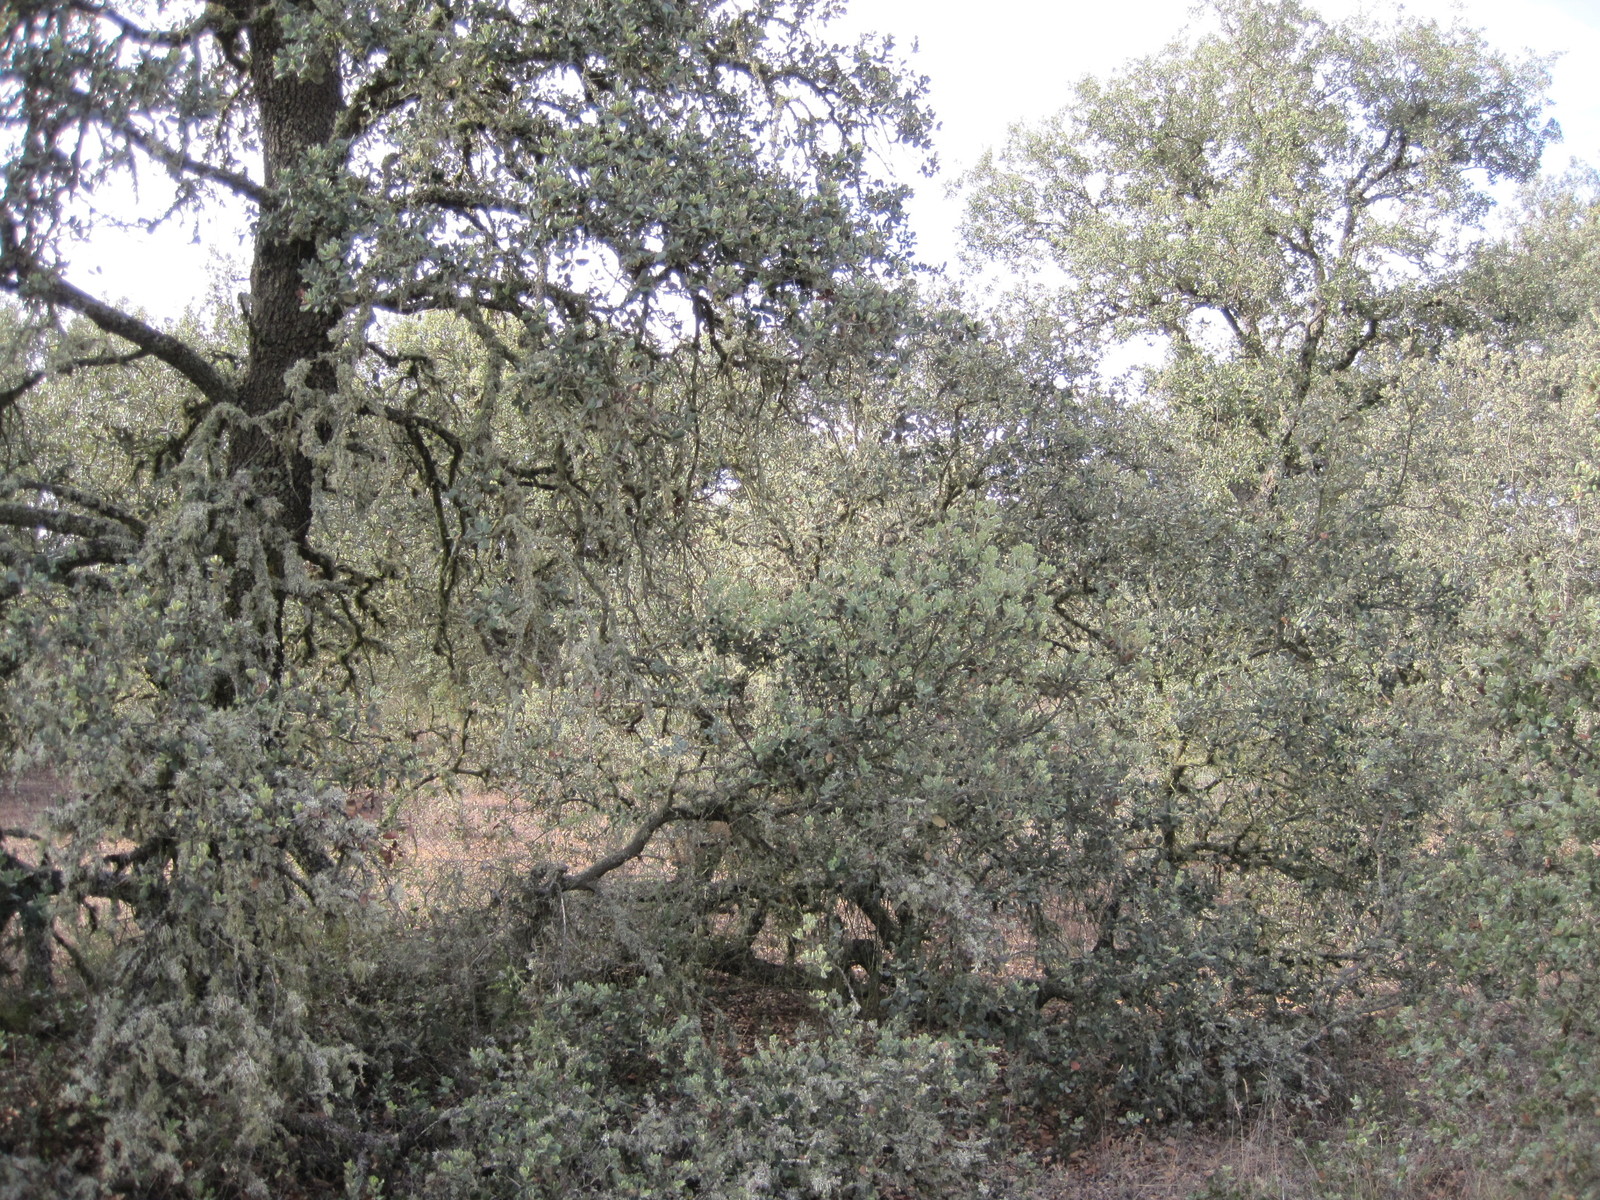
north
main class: Woodland
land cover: Broadleaved woodland
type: broadleaved evergreen forest
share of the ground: 50 - 75 %
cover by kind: broadleaved forest trees 70 %, herbaceous plants 30 %
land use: Forestry
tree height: > 5 m
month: July
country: ES
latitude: 41.9270
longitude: -5.6340
